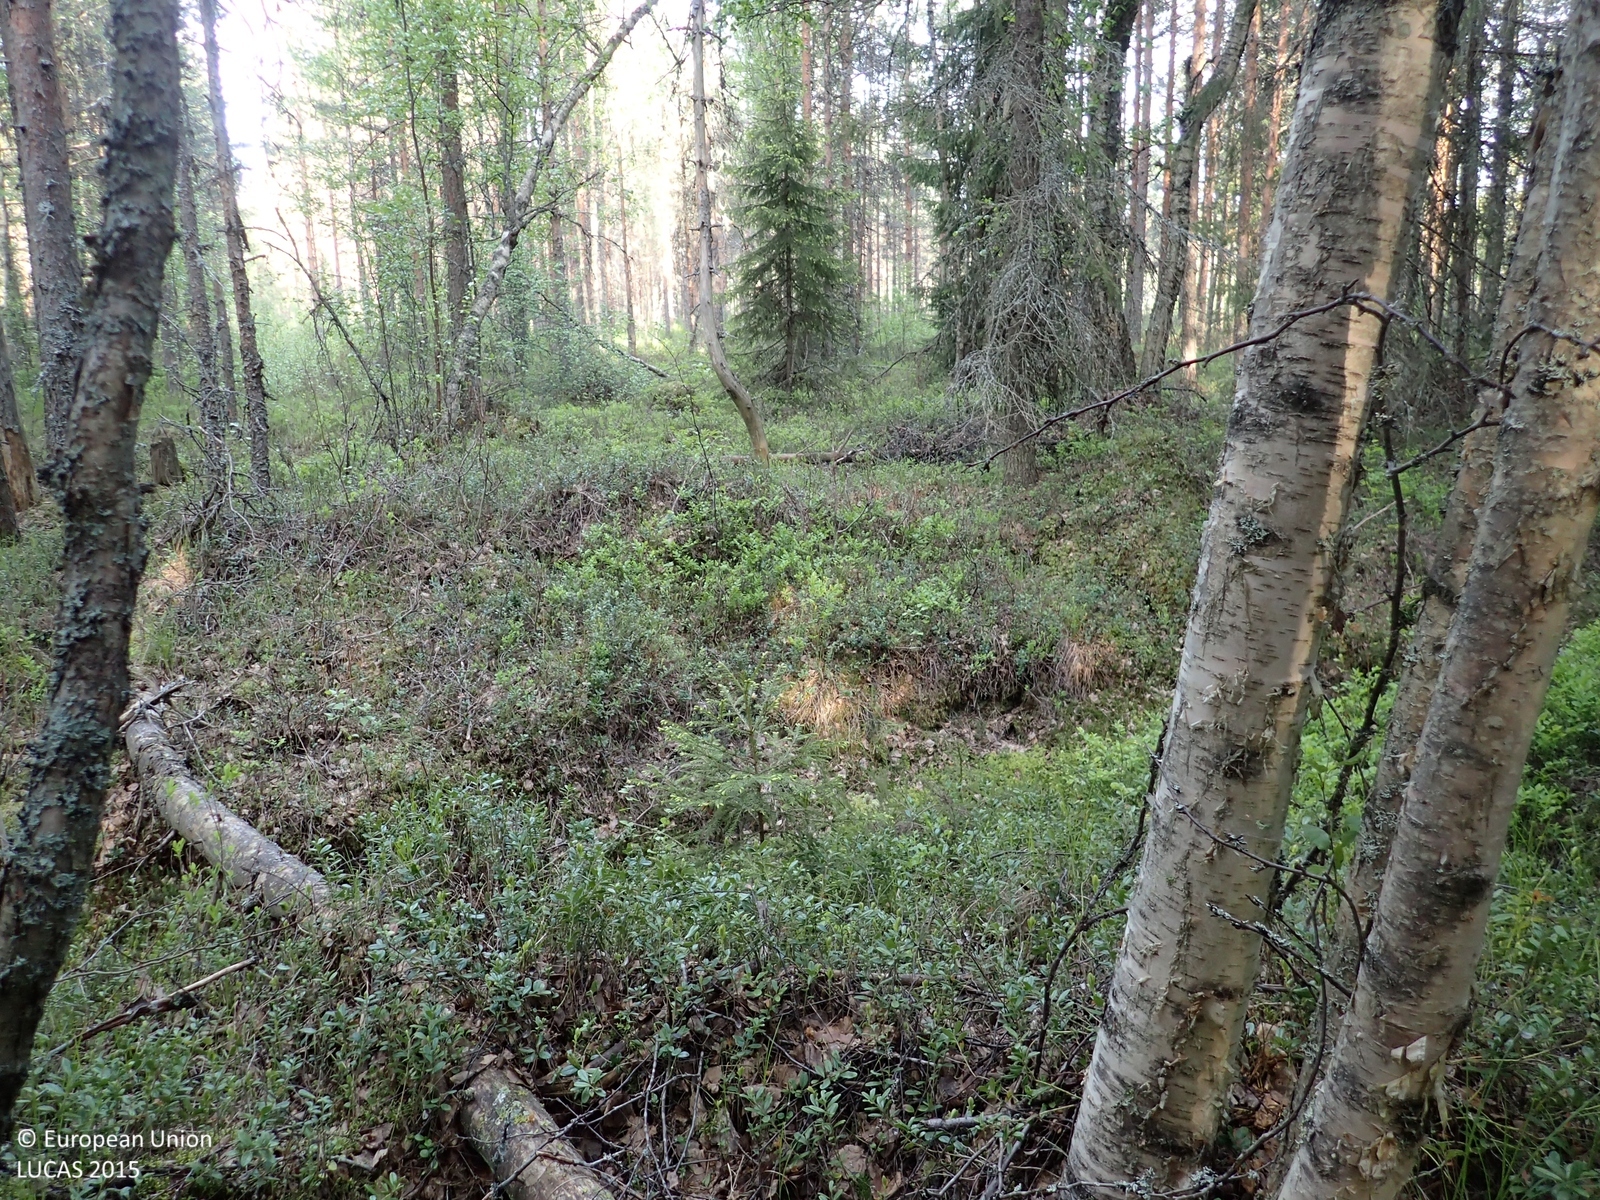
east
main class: Woodland
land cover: Spruce dominated coniferous woodland
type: boreal forest
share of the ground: > 75 %
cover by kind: coniferous forest trees 85 %, shrubs 10 %, broadleaved forest trees 5 %
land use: Forestry
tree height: > 5 m
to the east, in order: Spruce dominated coniferous woodland; Ditches and canals; Pine dominated coniferous woodland
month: June
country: FI
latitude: 62.3409
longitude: 22.5512
